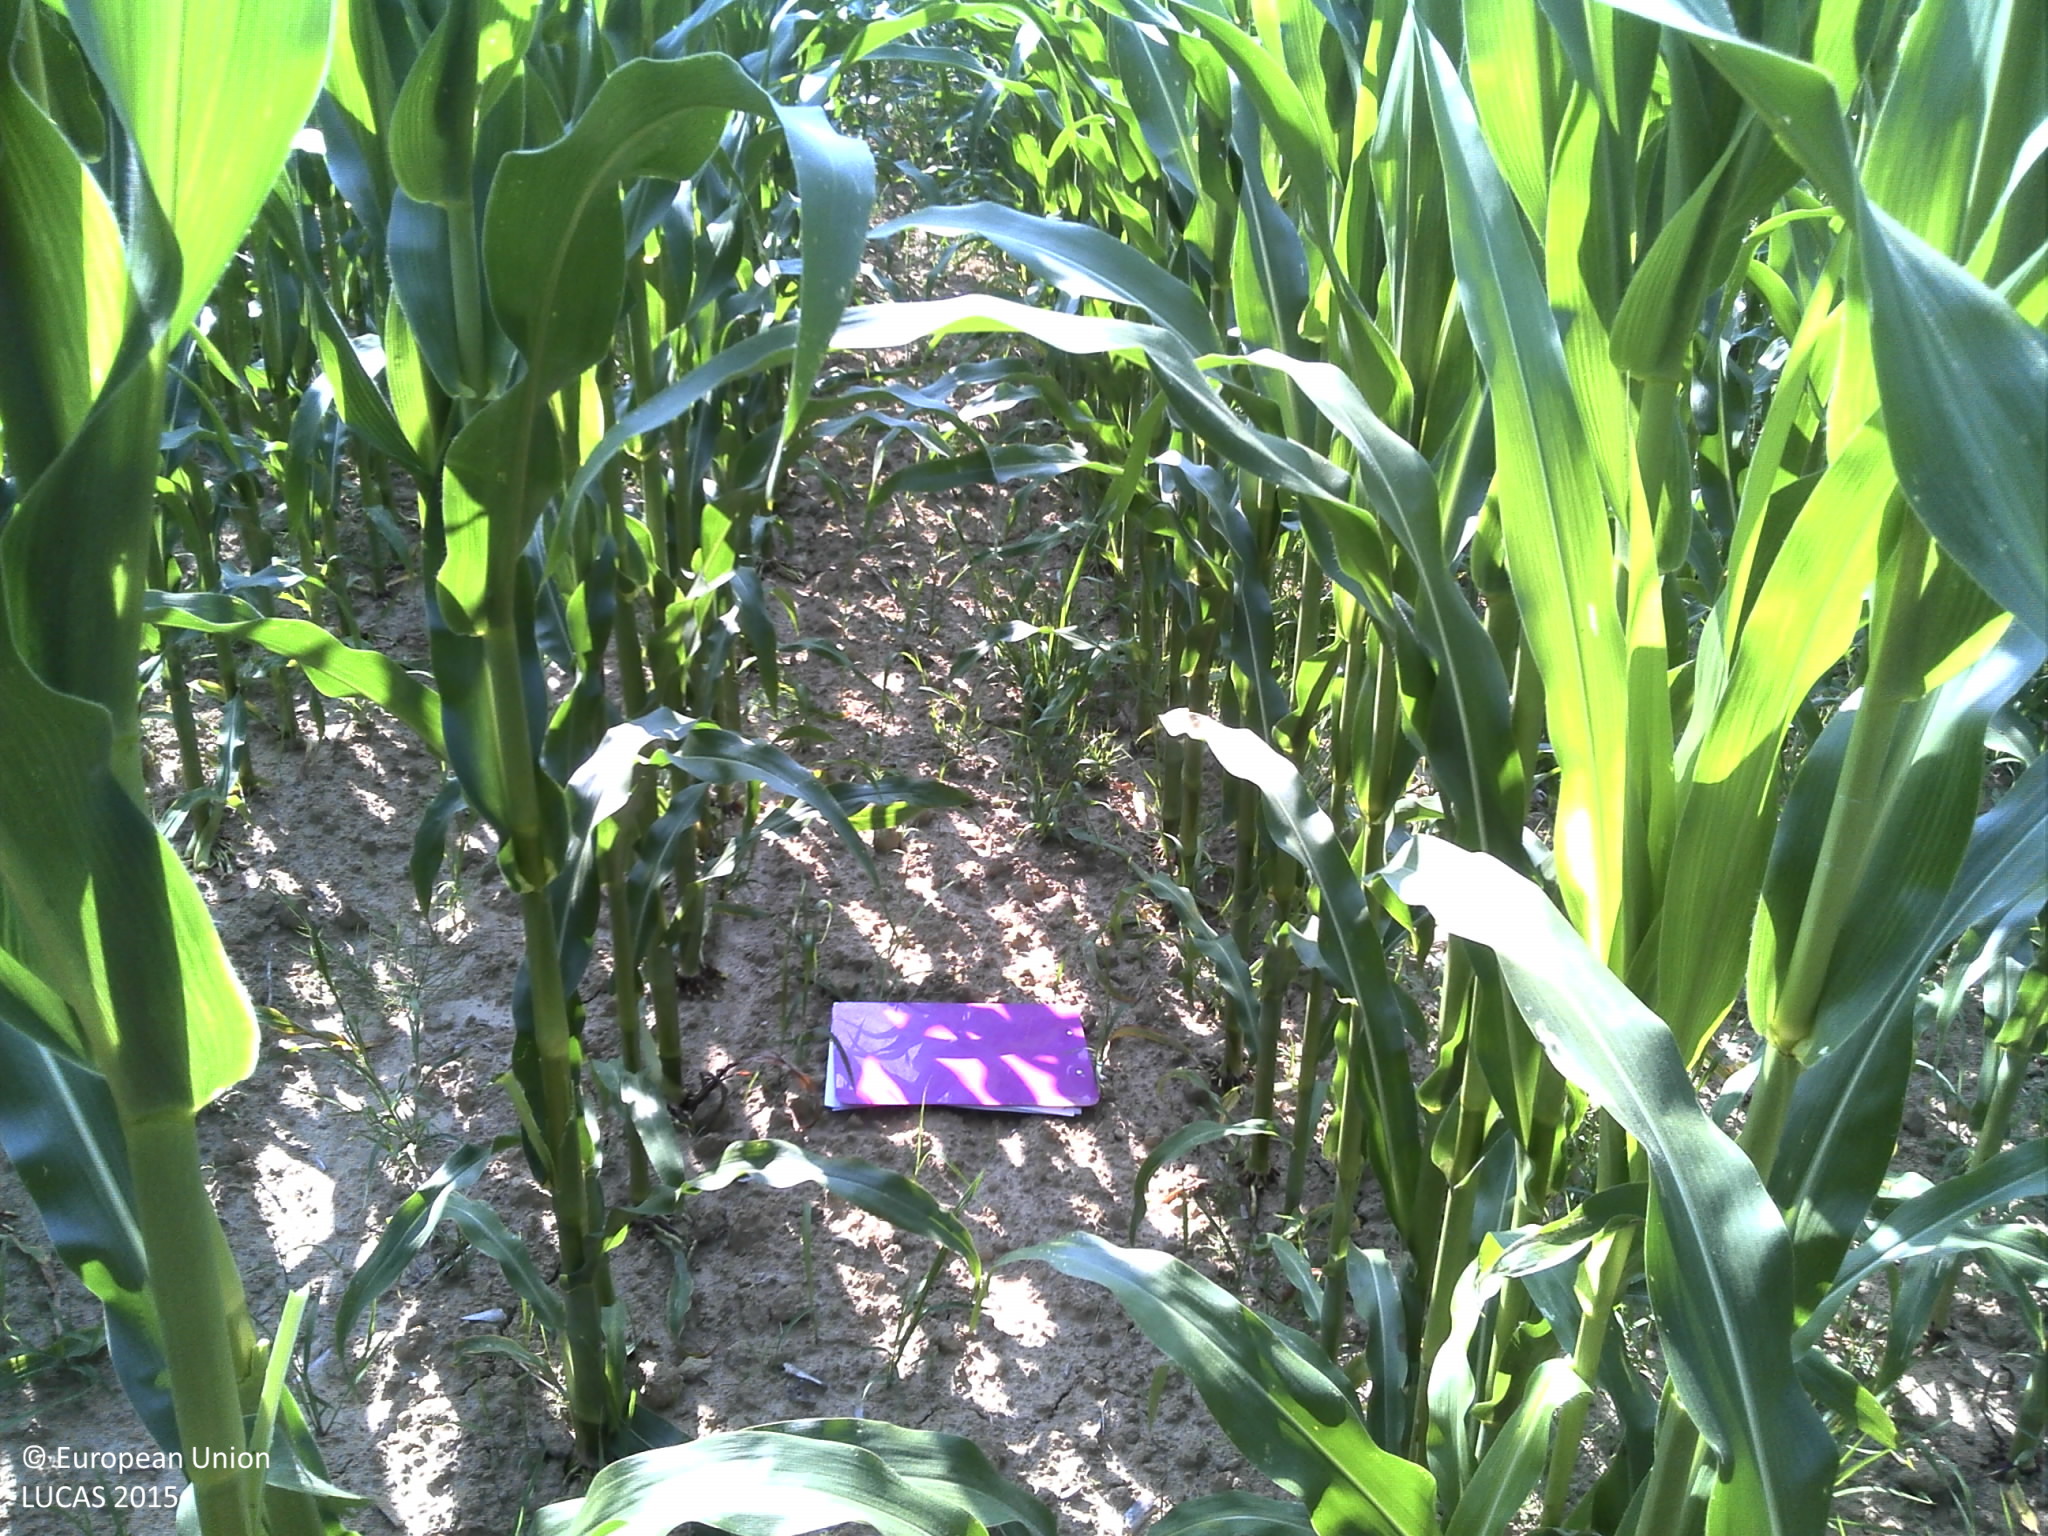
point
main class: Cropland
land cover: Maize
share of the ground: > 75 %
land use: Agriculture (excluding fallow land and kitchen gardens)
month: July
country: HR
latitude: 45.8007
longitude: 16.6514
